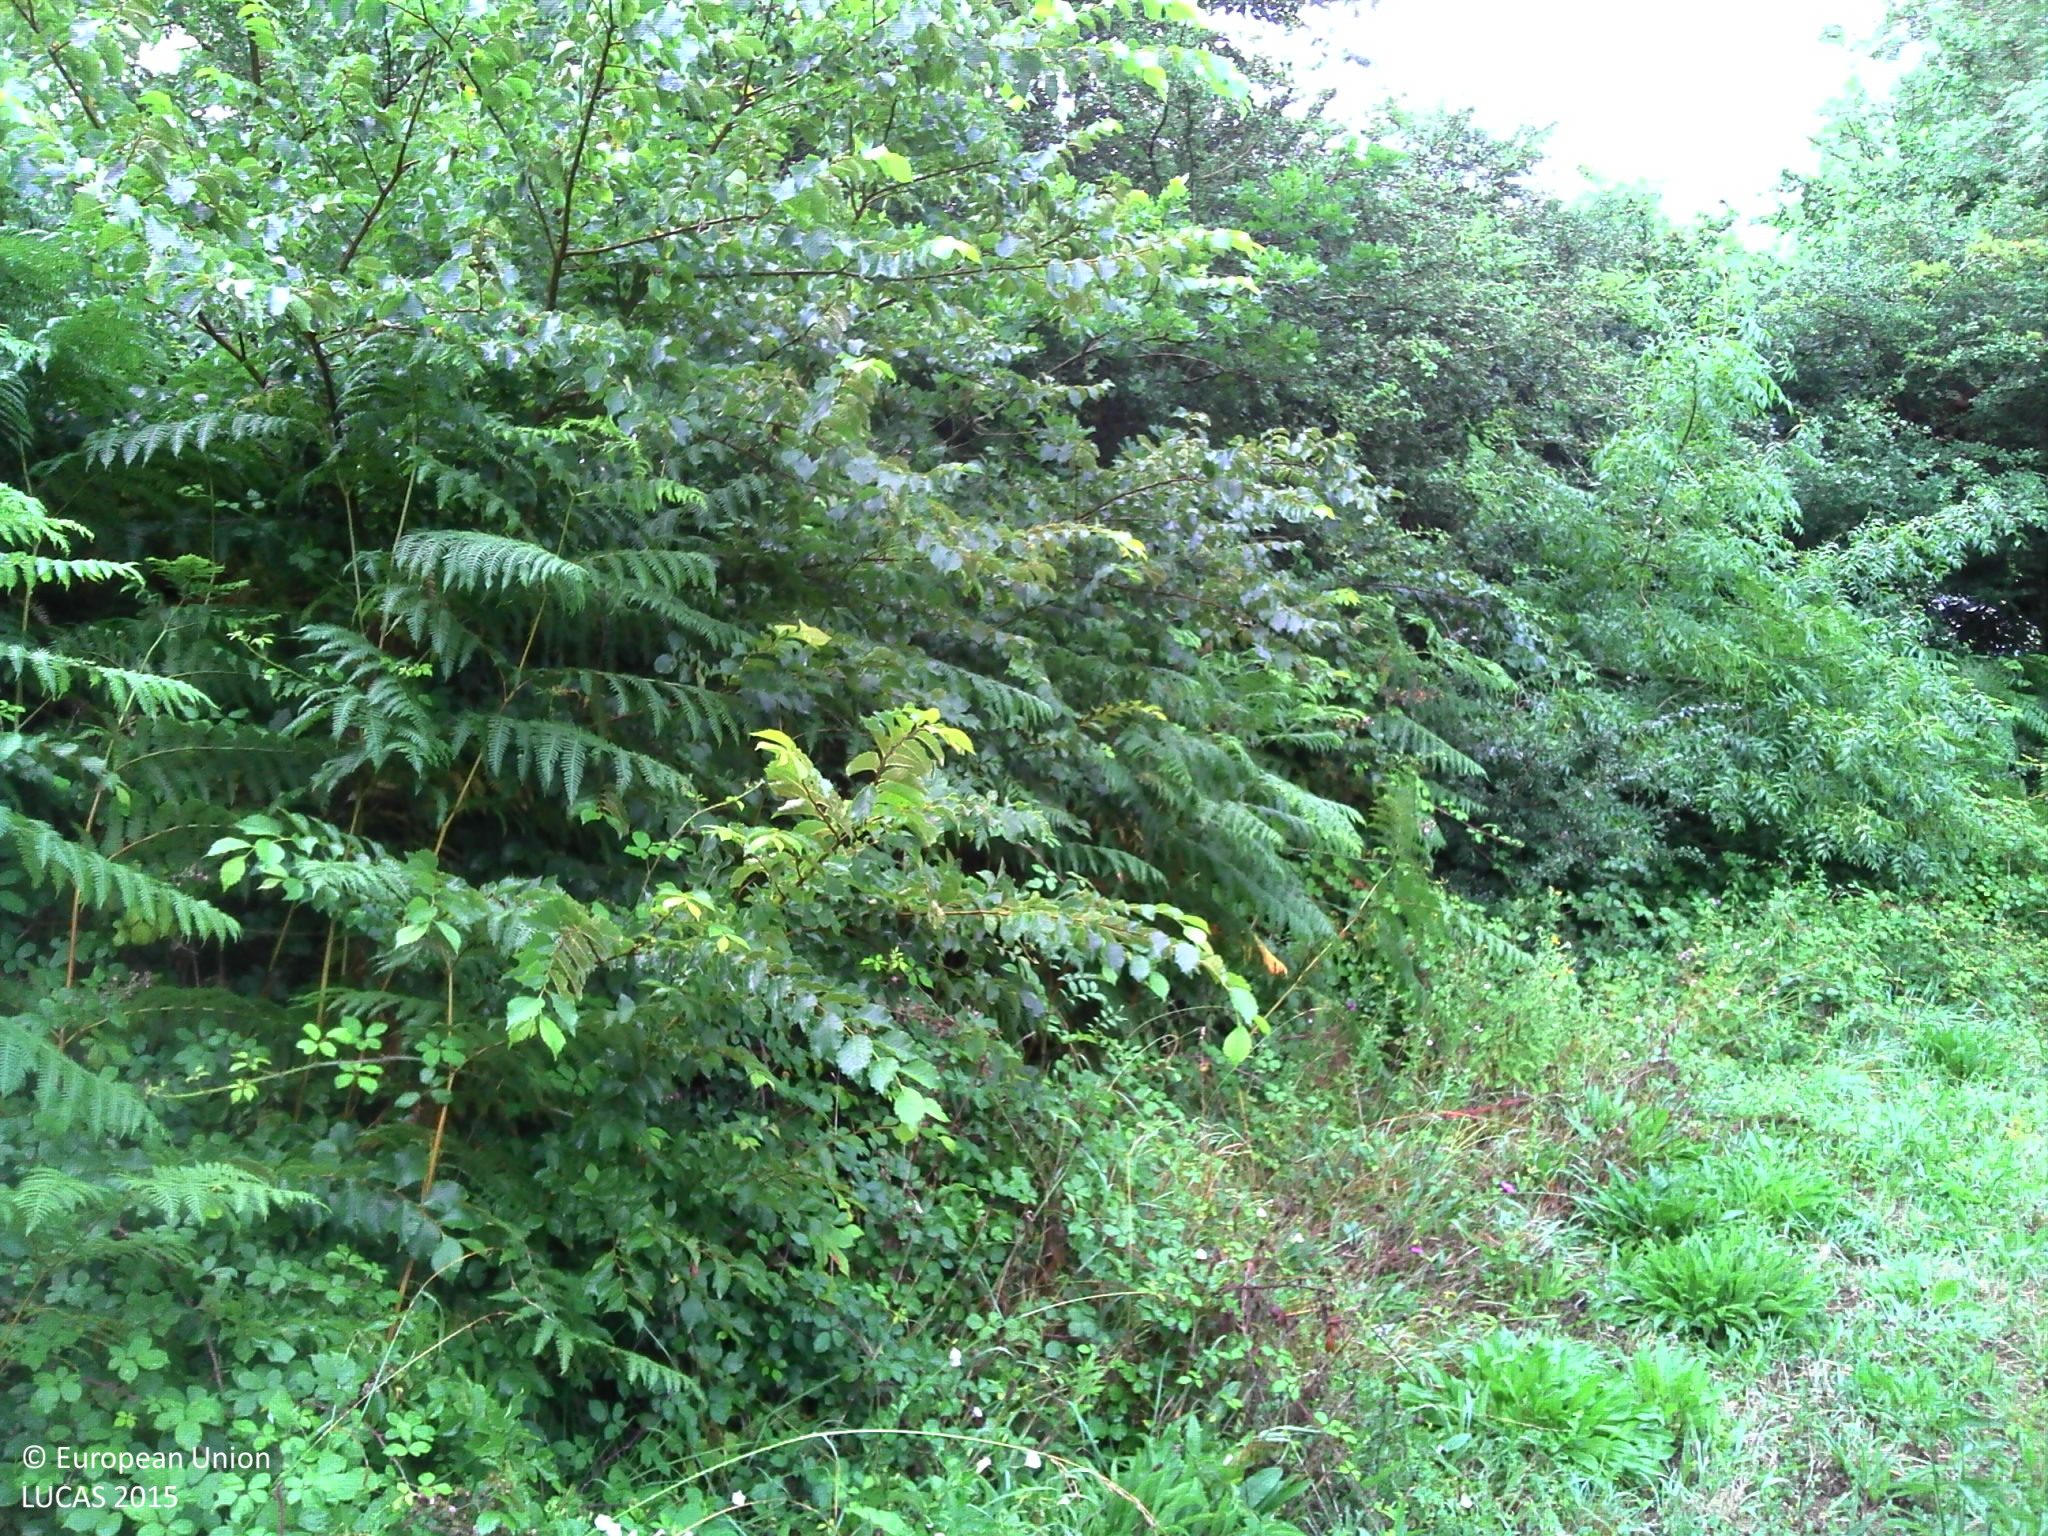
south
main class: Grassland
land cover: Grassland without tree/shrub cover
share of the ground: > 75 %
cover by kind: herbaceous plants 80 %, consolidated bare surface 20 %
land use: Agriculture (excluding fallow land and kitchen gardens)
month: July
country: FR
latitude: 47.6321
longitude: -3.1506
